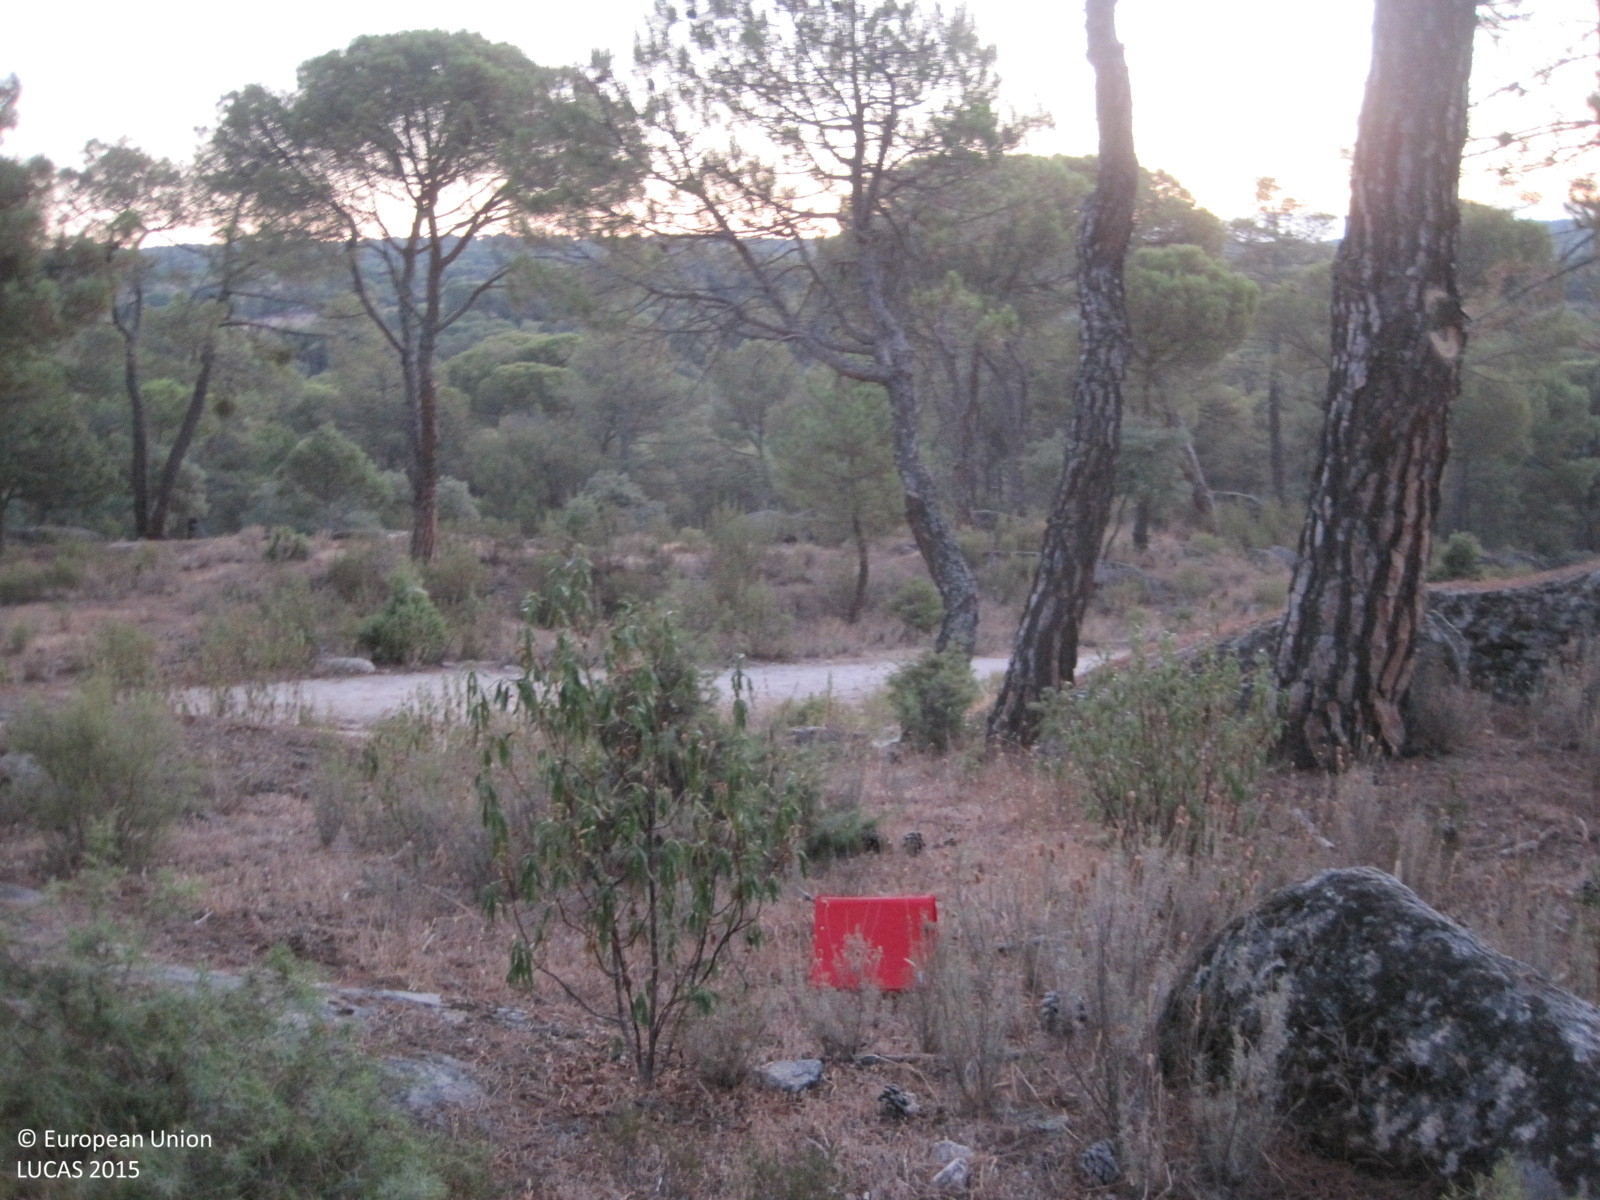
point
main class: Woodland
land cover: Pine dominated coniferous woodland
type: coniferous forest of the mediterranean region
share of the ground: > 75 %
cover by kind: coniferous forest trees 80 %, shrubs 20 %
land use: Forestry
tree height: > 5 m
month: July
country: ES
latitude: 40.3190
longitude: -4.3915
